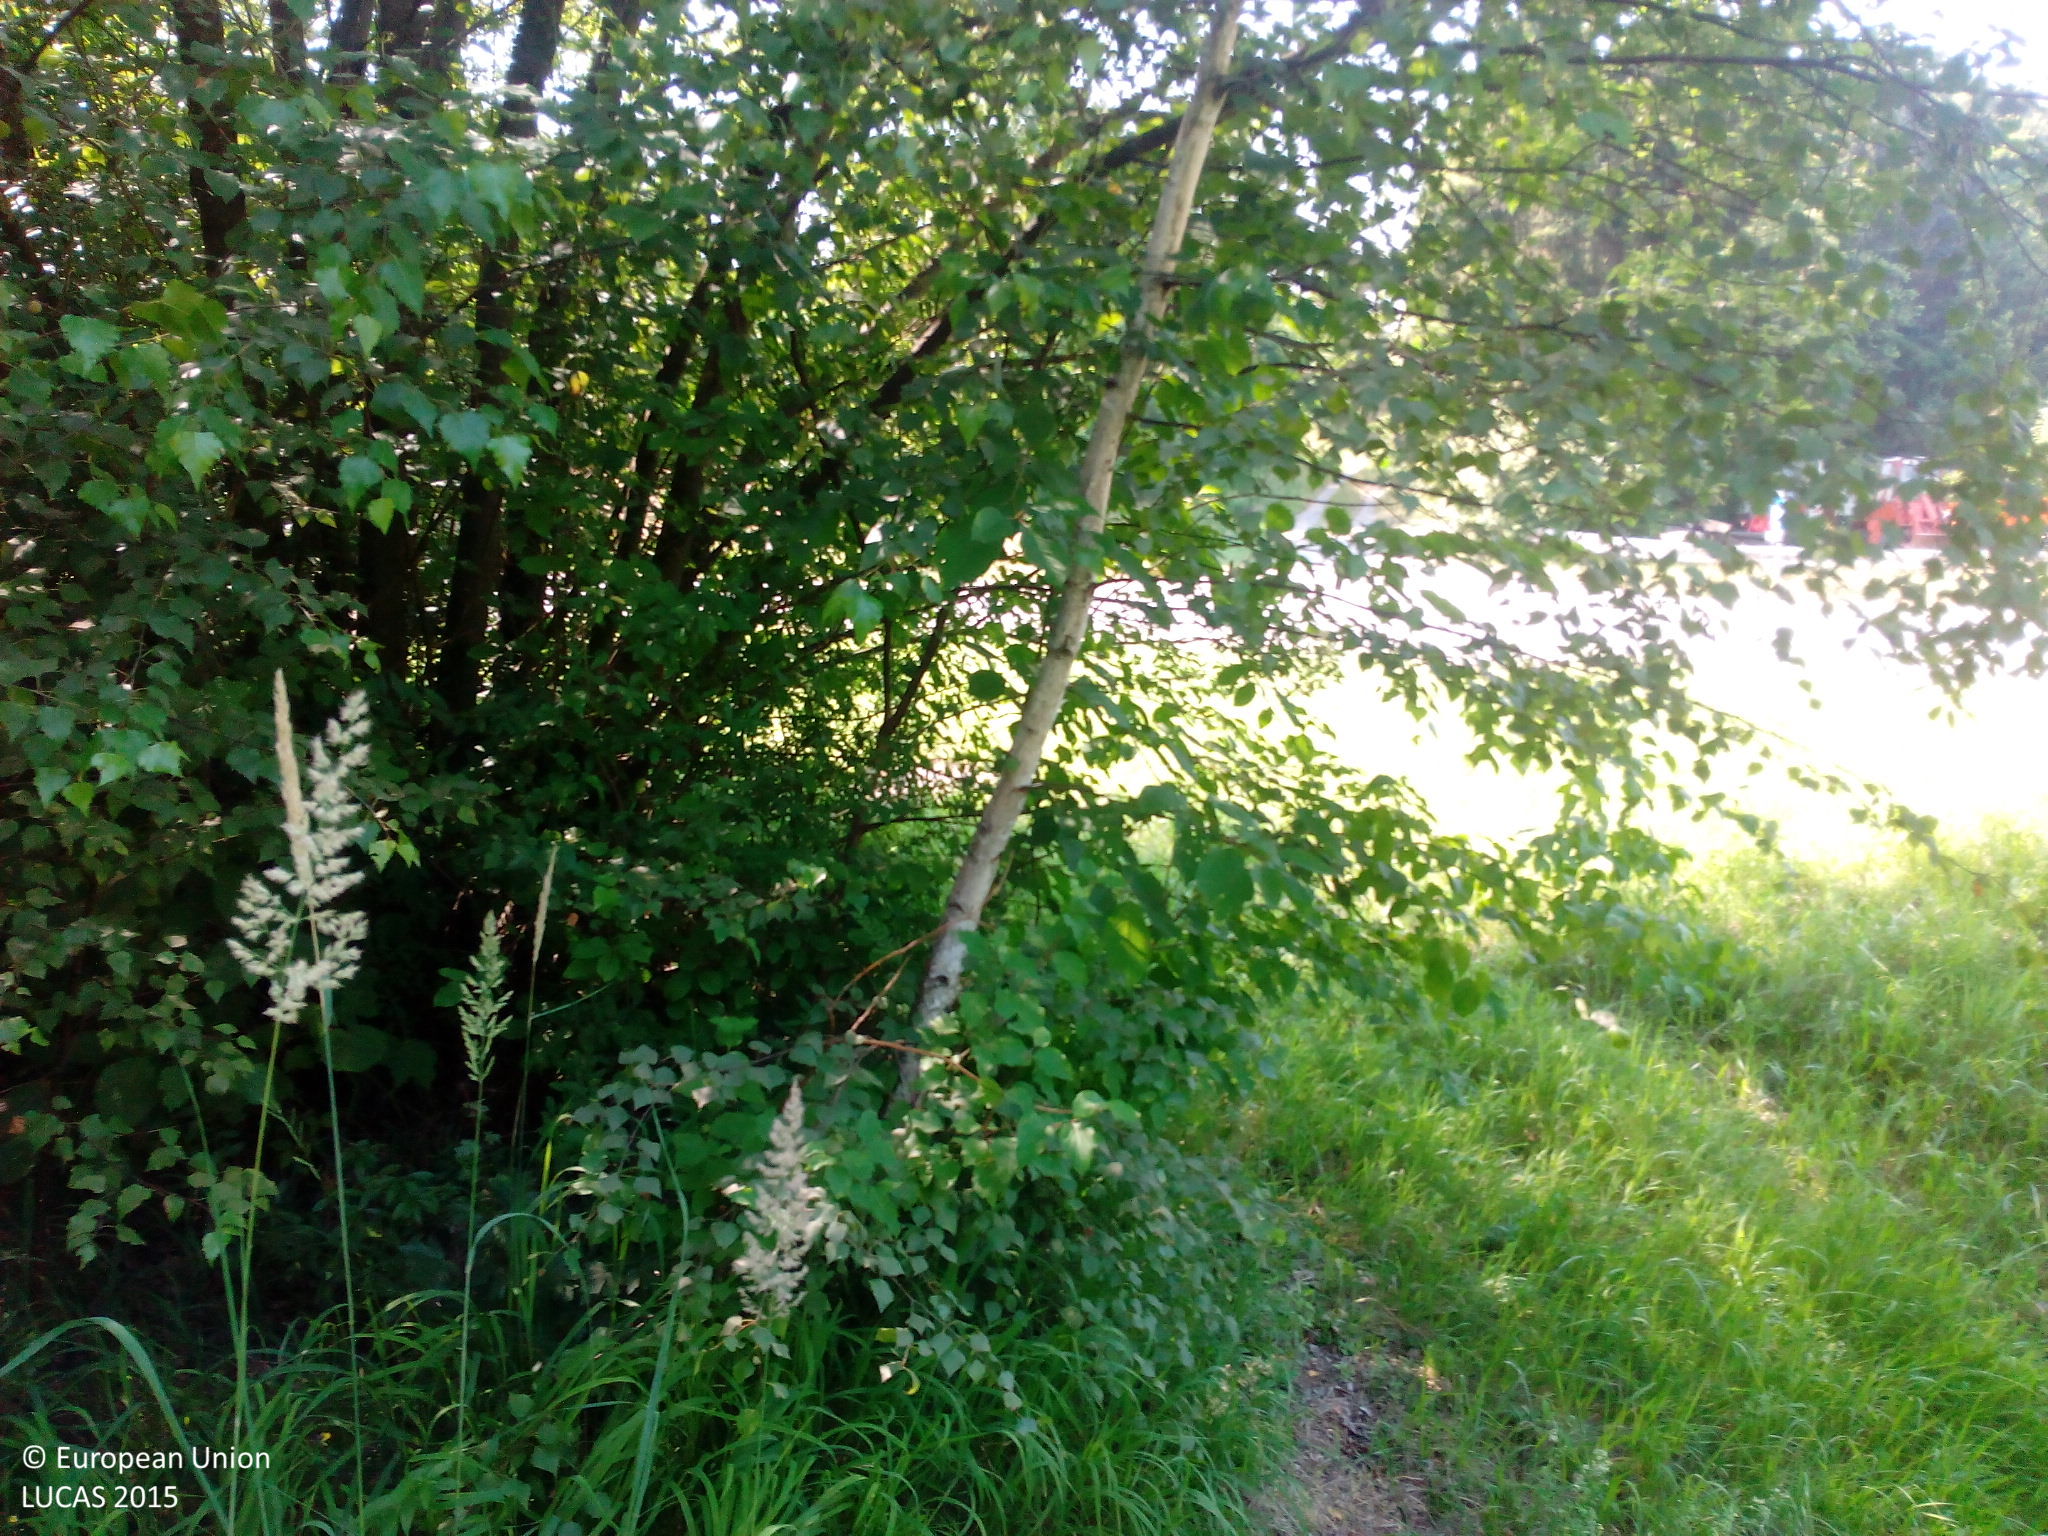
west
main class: Grassland
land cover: Grassland without tree/shrub cover
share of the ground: > 75 %
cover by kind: herbaceous plants 100 %
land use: Road transport
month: July
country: DE
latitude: 47.7706
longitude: 9.1867
